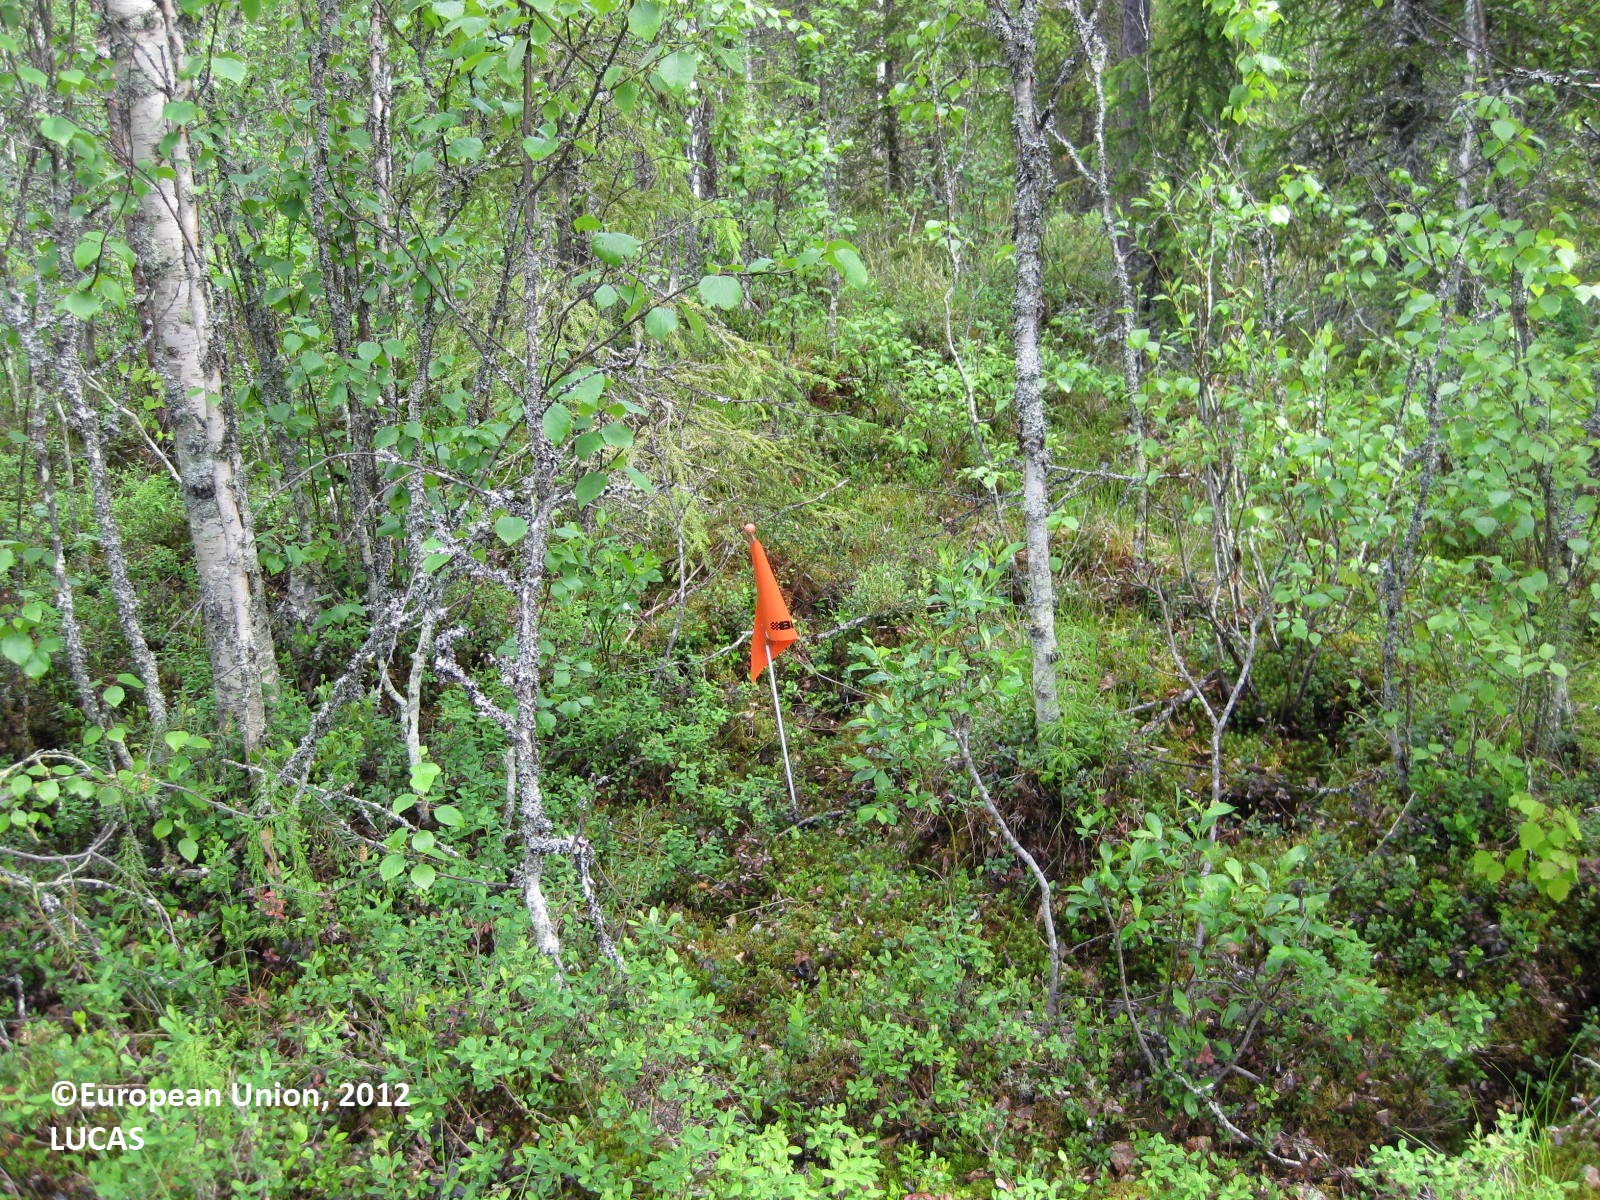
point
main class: Woodland
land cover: Other mixed woodland
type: boreal forest
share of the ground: > 75 %
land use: Forestry
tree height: > 5 m
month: June
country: FI
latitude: 65.1444
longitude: 28.1726
